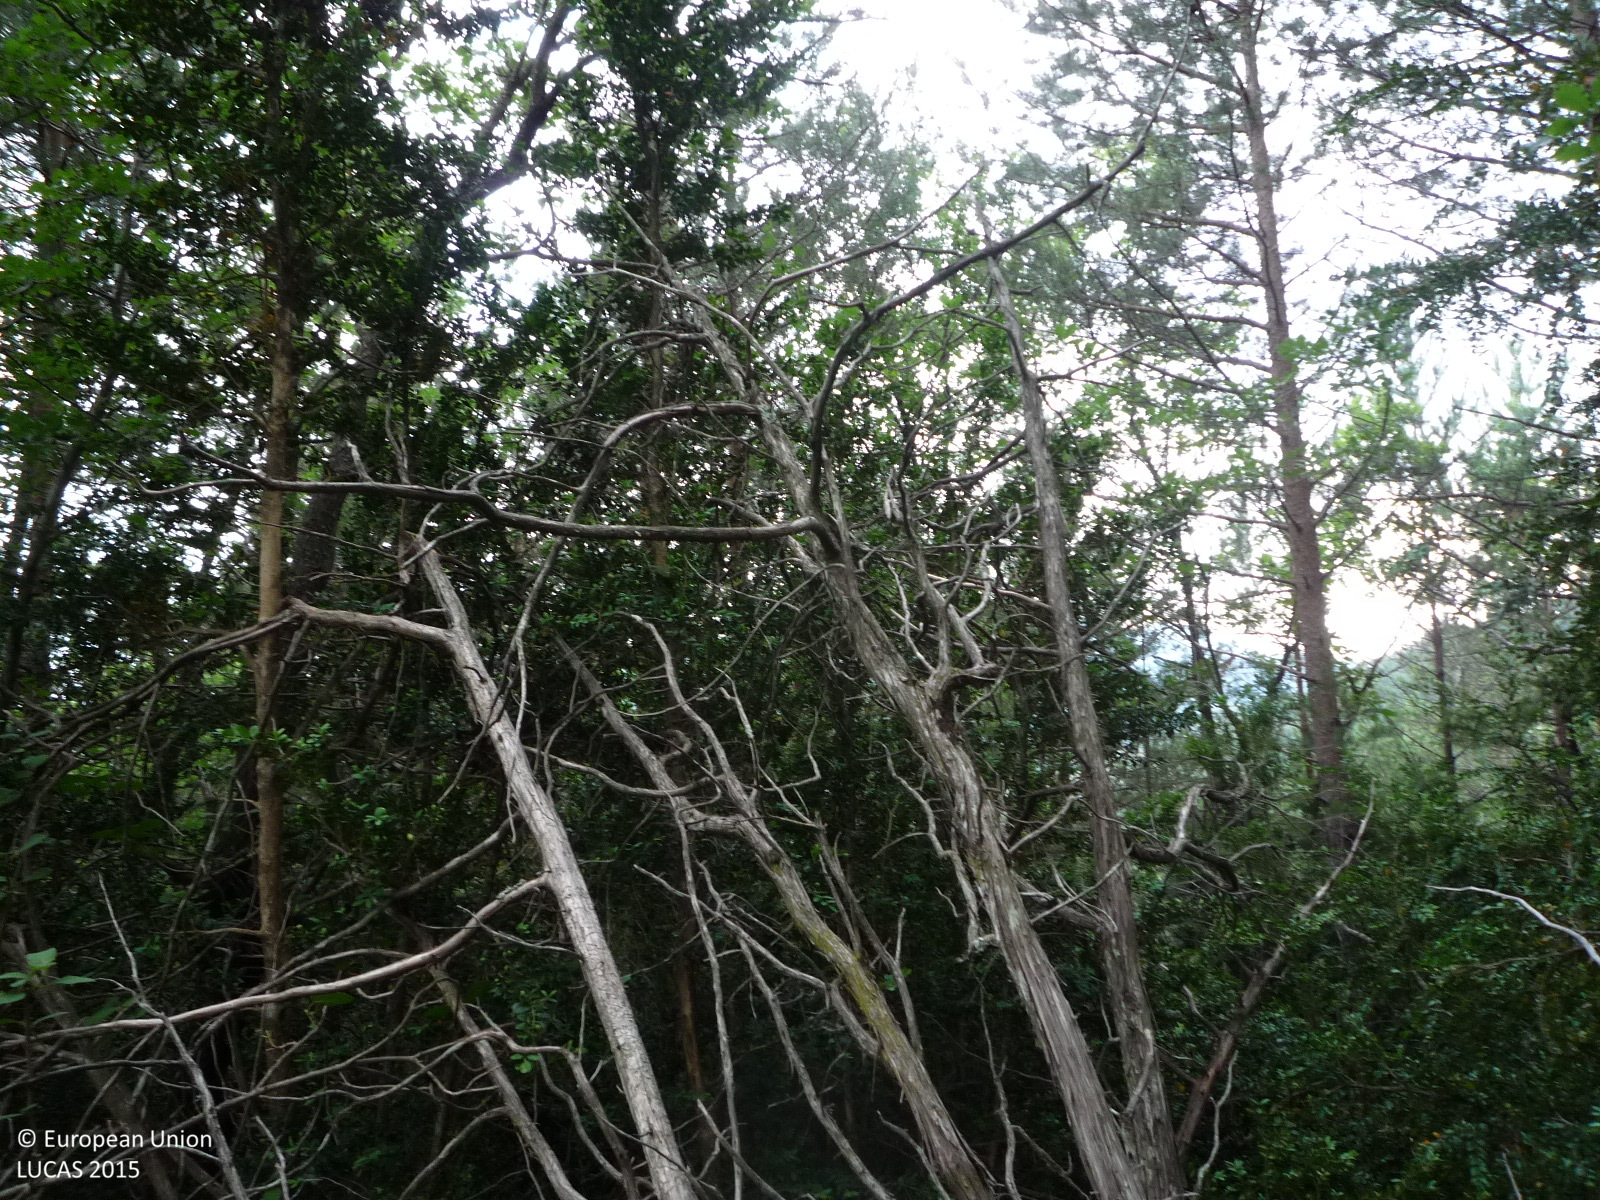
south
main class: Woodland
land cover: Pine dominated mixed woodland
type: alpine coniferous forest
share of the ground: > 75 %
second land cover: Shrubland without tree cover
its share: < 10 %
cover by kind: coniferous forest trees 60 %, broadleaved forest trees 30 %, shrubs 10 %
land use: Forestry
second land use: Agriculture (excluding fallow land and kitchen gardens)
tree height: > 5 m
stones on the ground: < 10 %
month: June
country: ES
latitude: 42.2626
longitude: 1.9749
